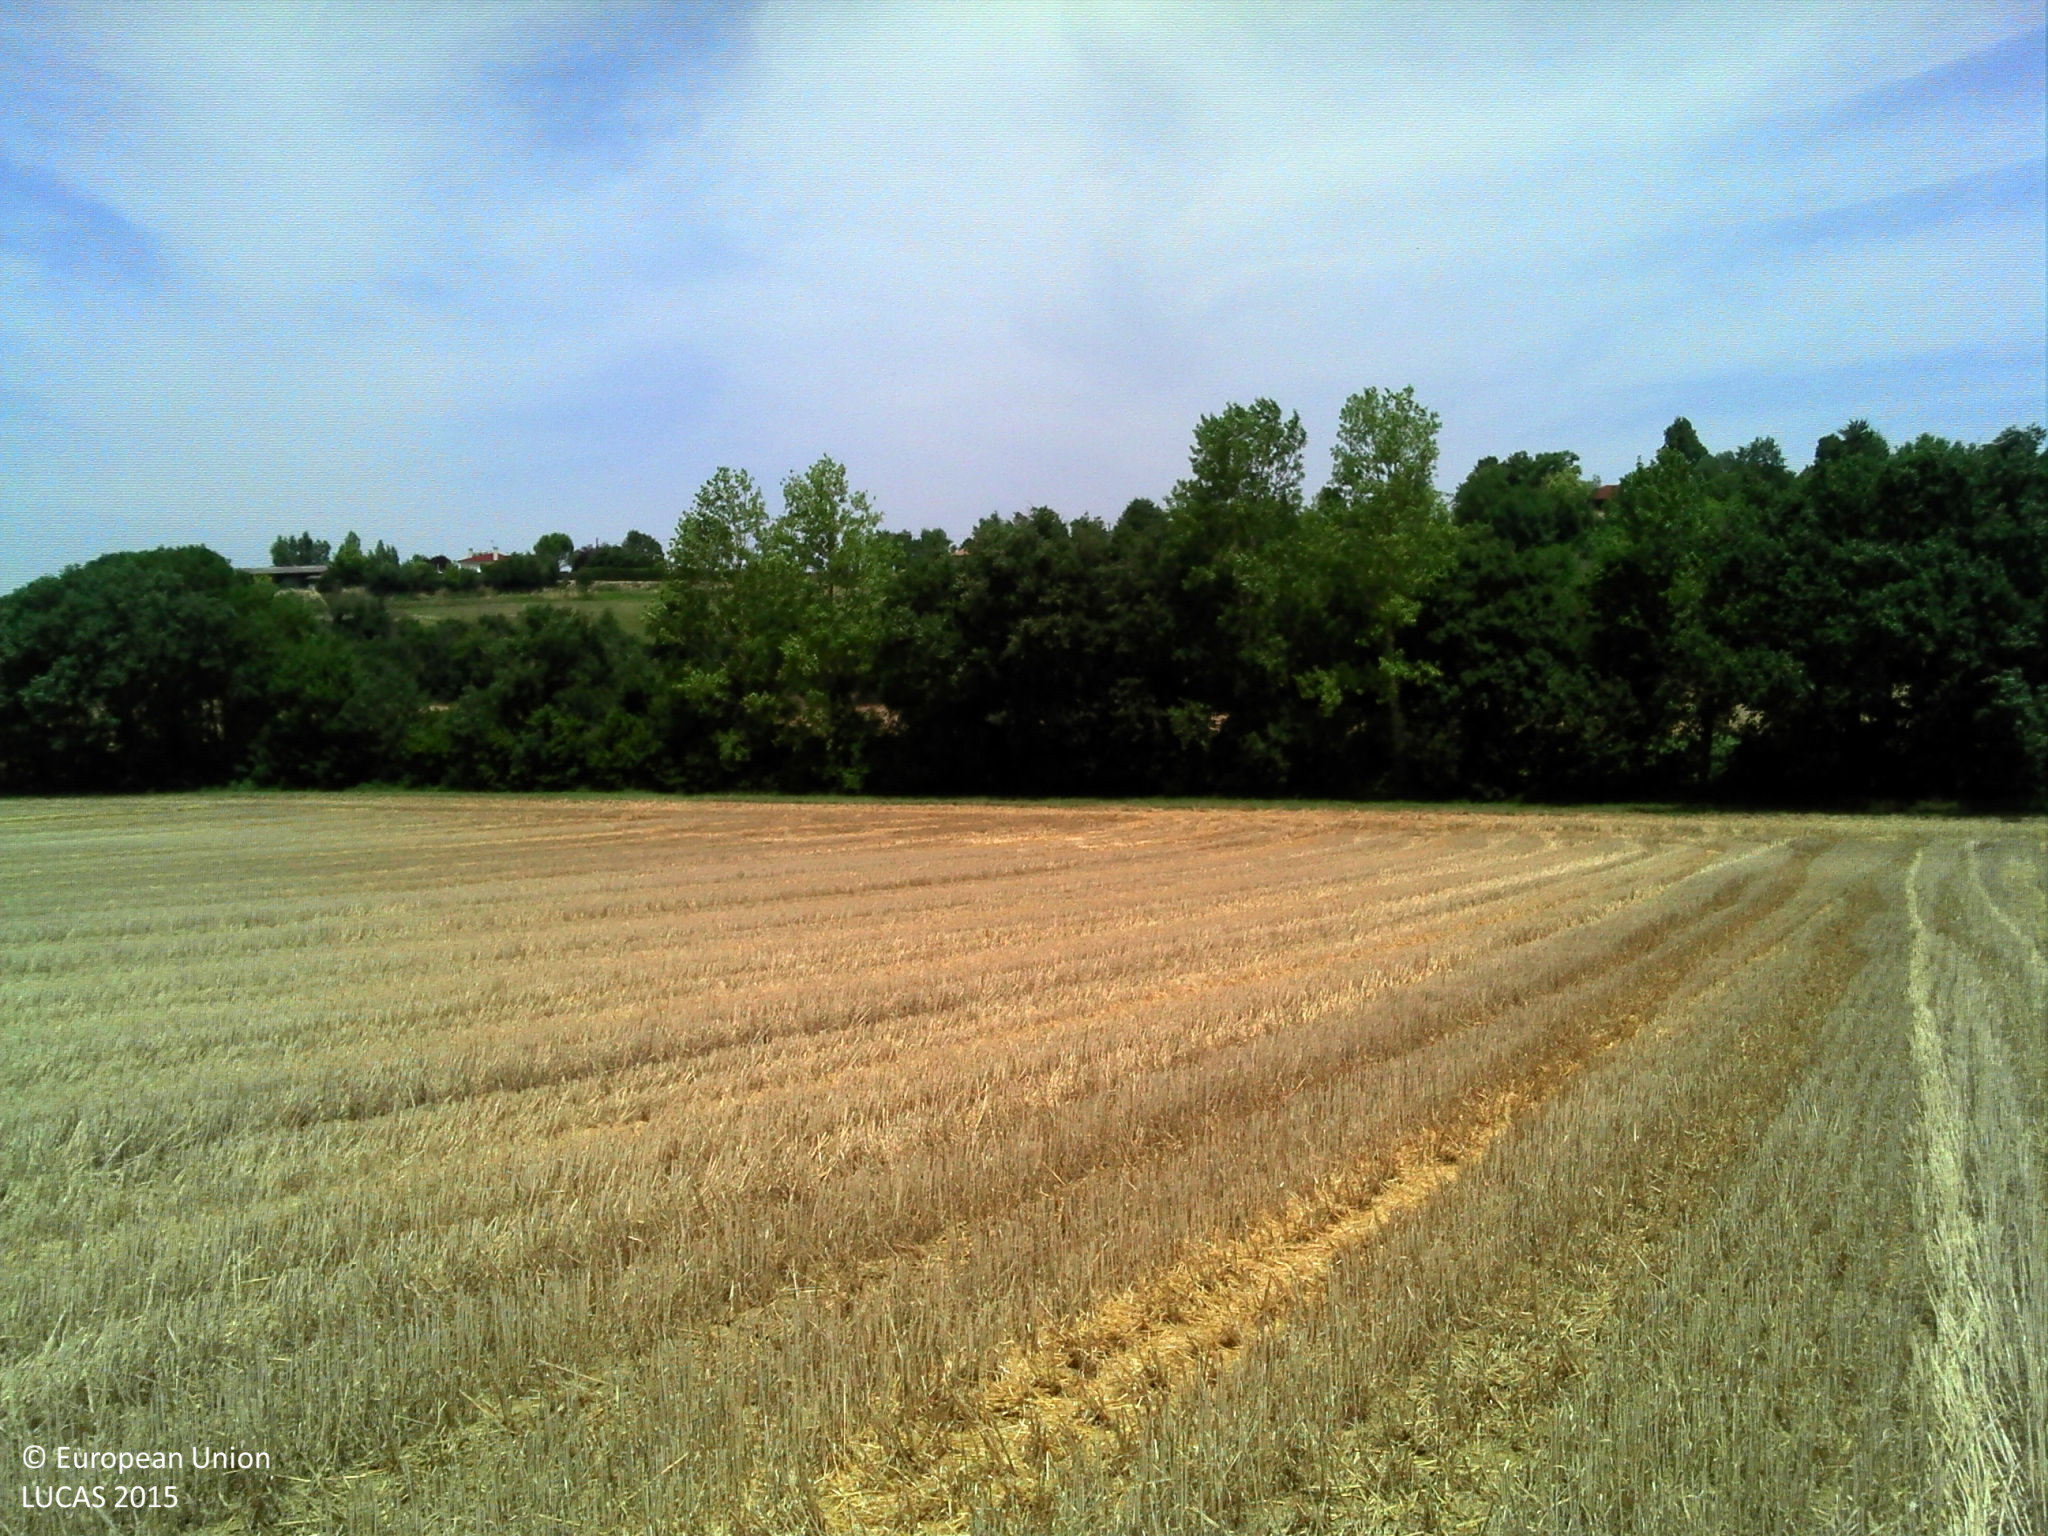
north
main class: Cropland
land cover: Durum wheat
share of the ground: > 75 %
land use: Agriculture (excluding fallow land and kitchen gardens)
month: July
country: FR
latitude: 43.5640
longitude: 1.0497
